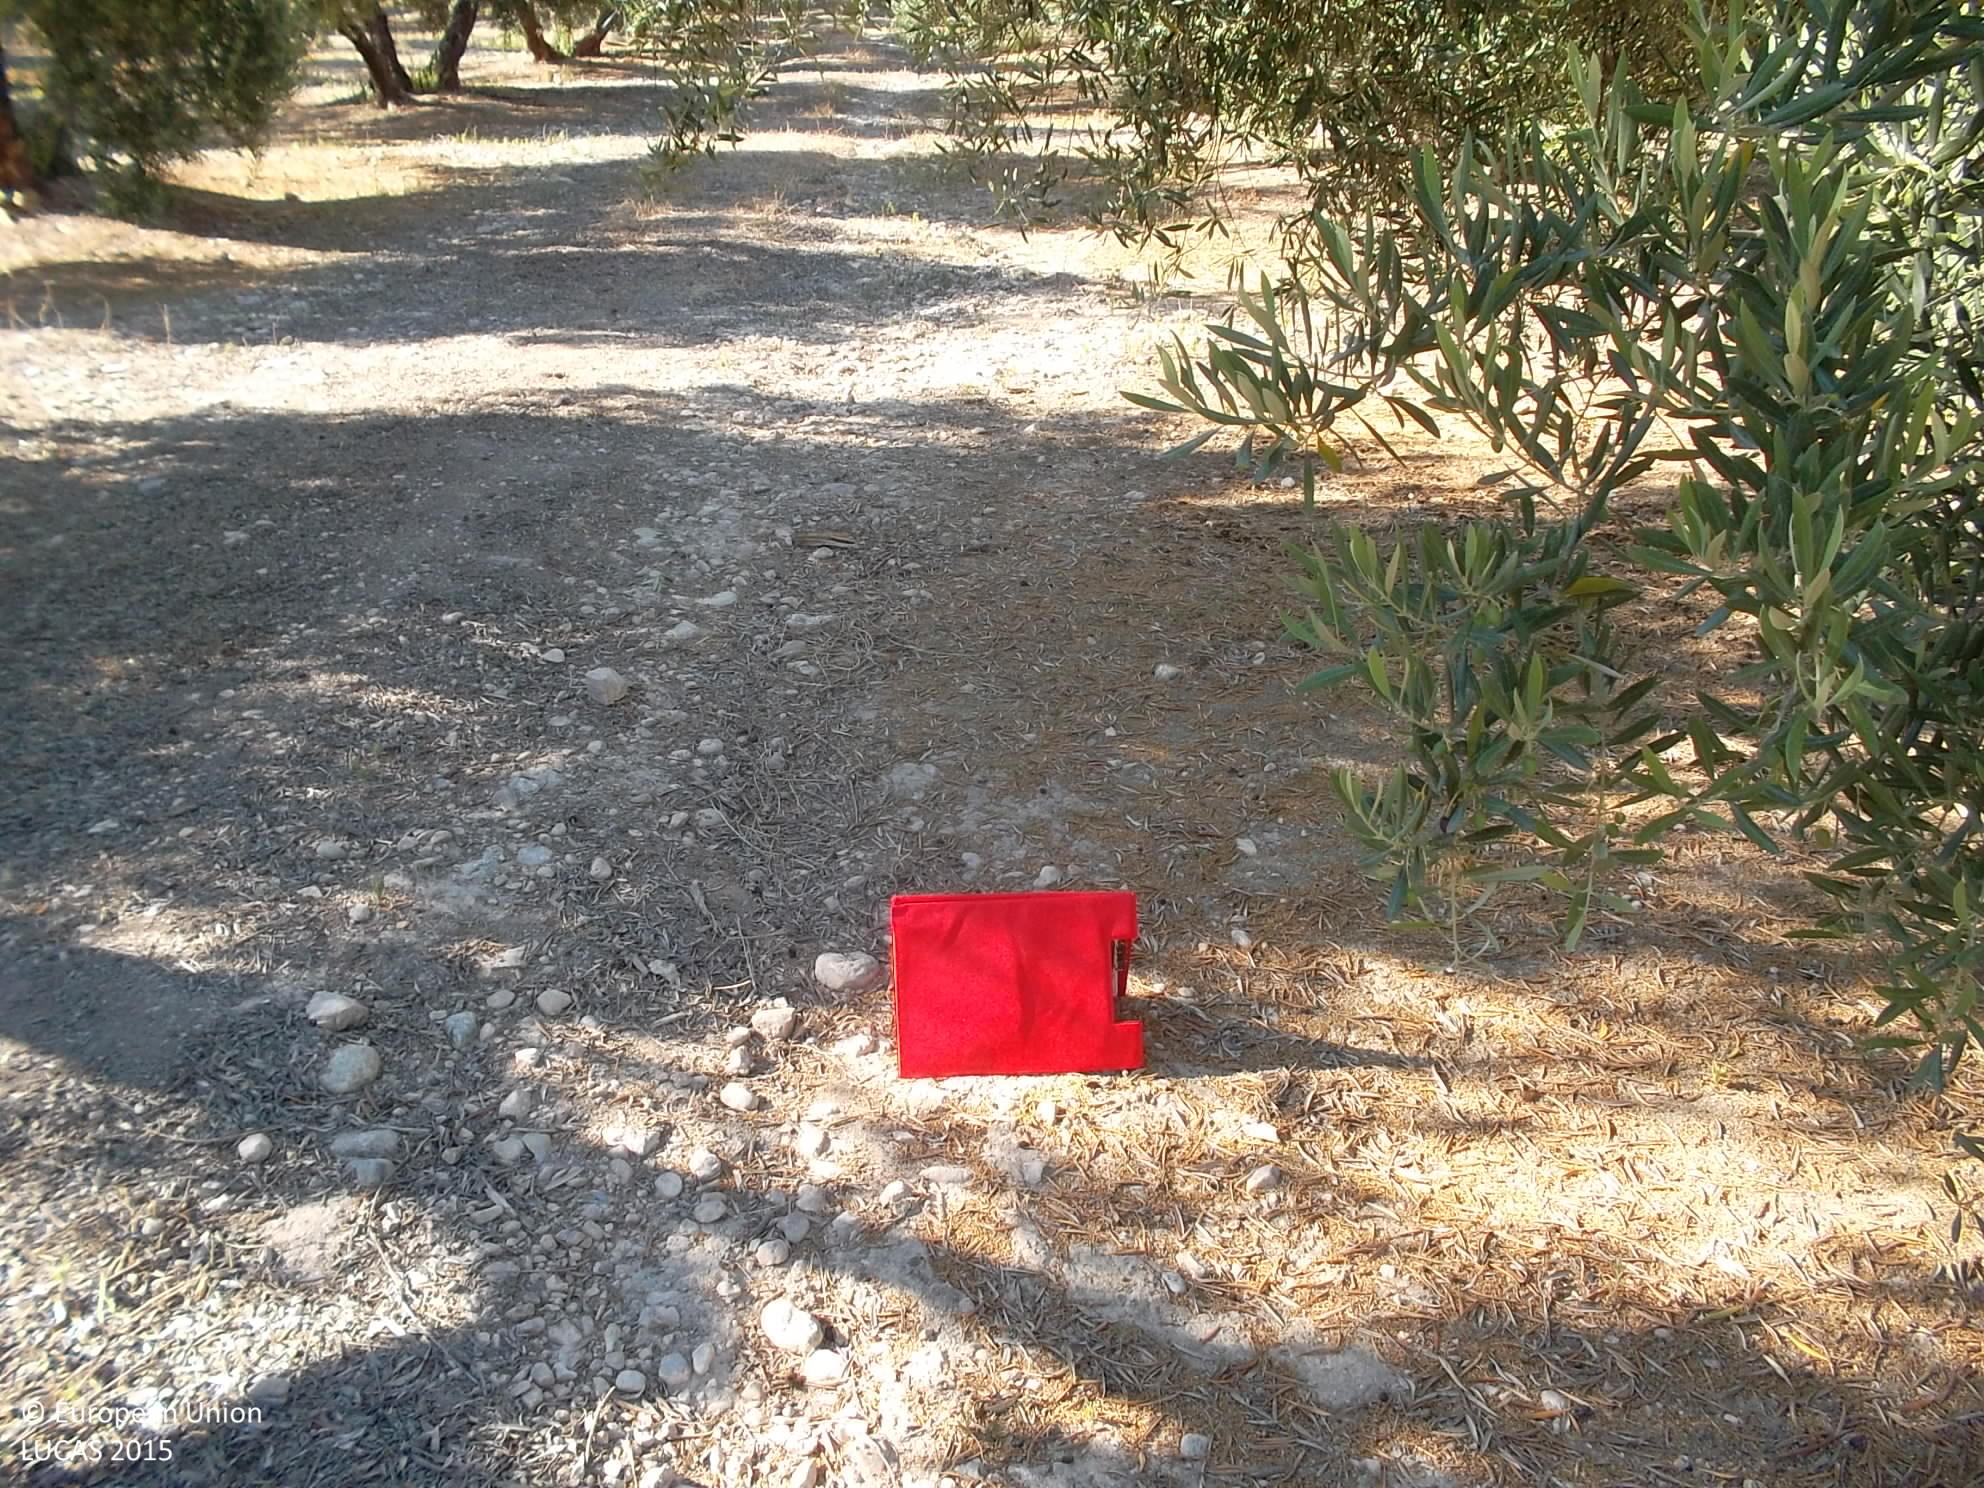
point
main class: Cropland
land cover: Olive groves
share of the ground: 50 - 75 %
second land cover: Other bare soil
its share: > 75 %
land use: Agriculture (excluding fallow land and kitchen gardens)
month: June
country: ES
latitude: 38.0131
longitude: -3.0844
